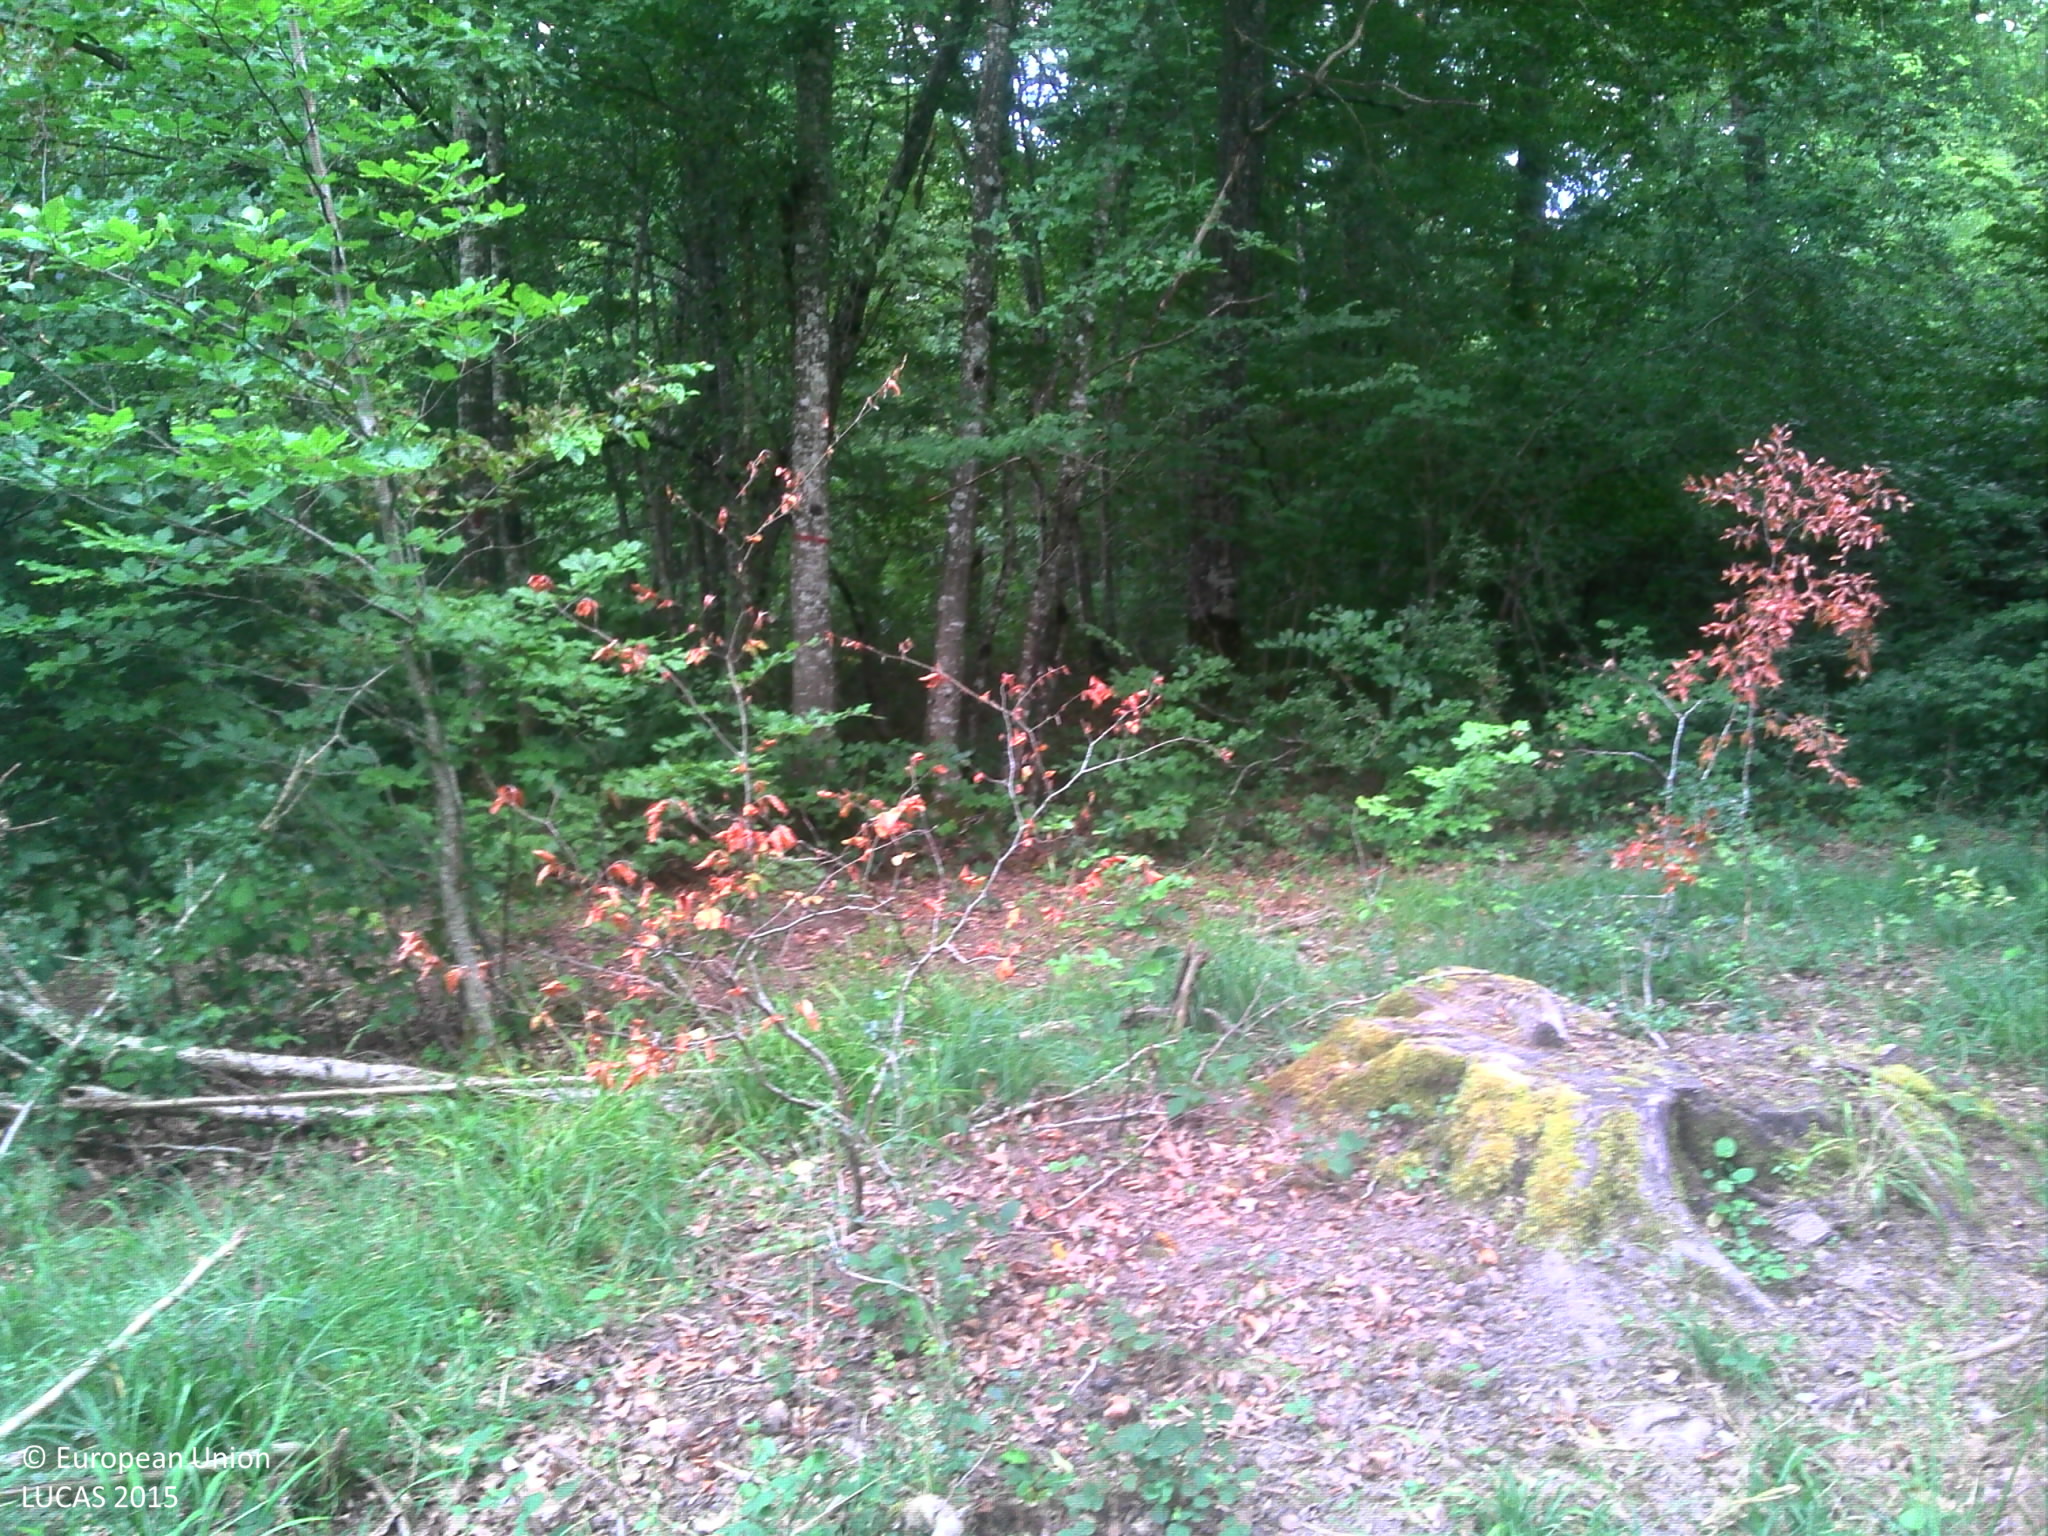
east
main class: Woodland
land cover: Broadleaved woodland
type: beech forest
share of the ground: > 75 %
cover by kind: broadleaved forest trees 90 %, herbaceous plants 10 %
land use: Forestry
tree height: > 5 m
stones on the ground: < 10 %
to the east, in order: Broadleaved woodland; Tracks; Broadleaved woodland; Tracks; Broadleaved woodland
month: July
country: FR
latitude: 48.1790
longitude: 4.9284
